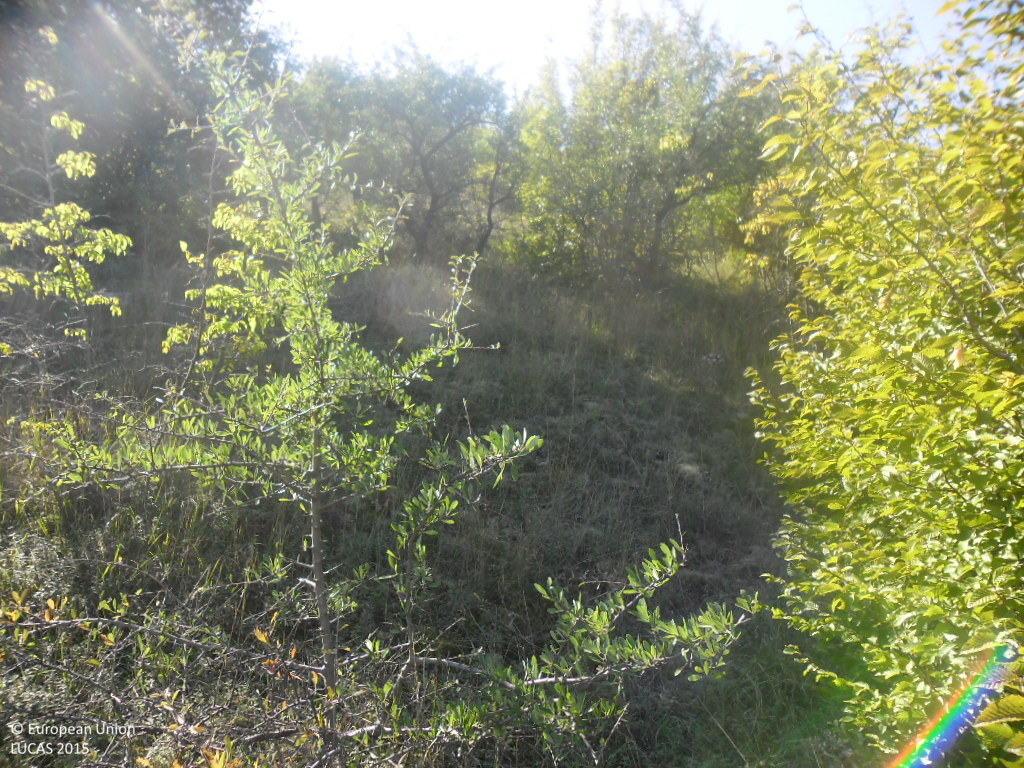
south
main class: Shrubland
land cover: Shrubland with sparse tree cover
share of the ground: 50 - 75 %
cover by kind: shrubs 65 %, herbaceous plants 30 %, broadleaved forest trees 5 %
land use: Agriculture (excluding fallow land and kitchen gardens)
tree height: < 5 m
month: October
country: BG
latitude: 41.4652
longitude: 23.2749
